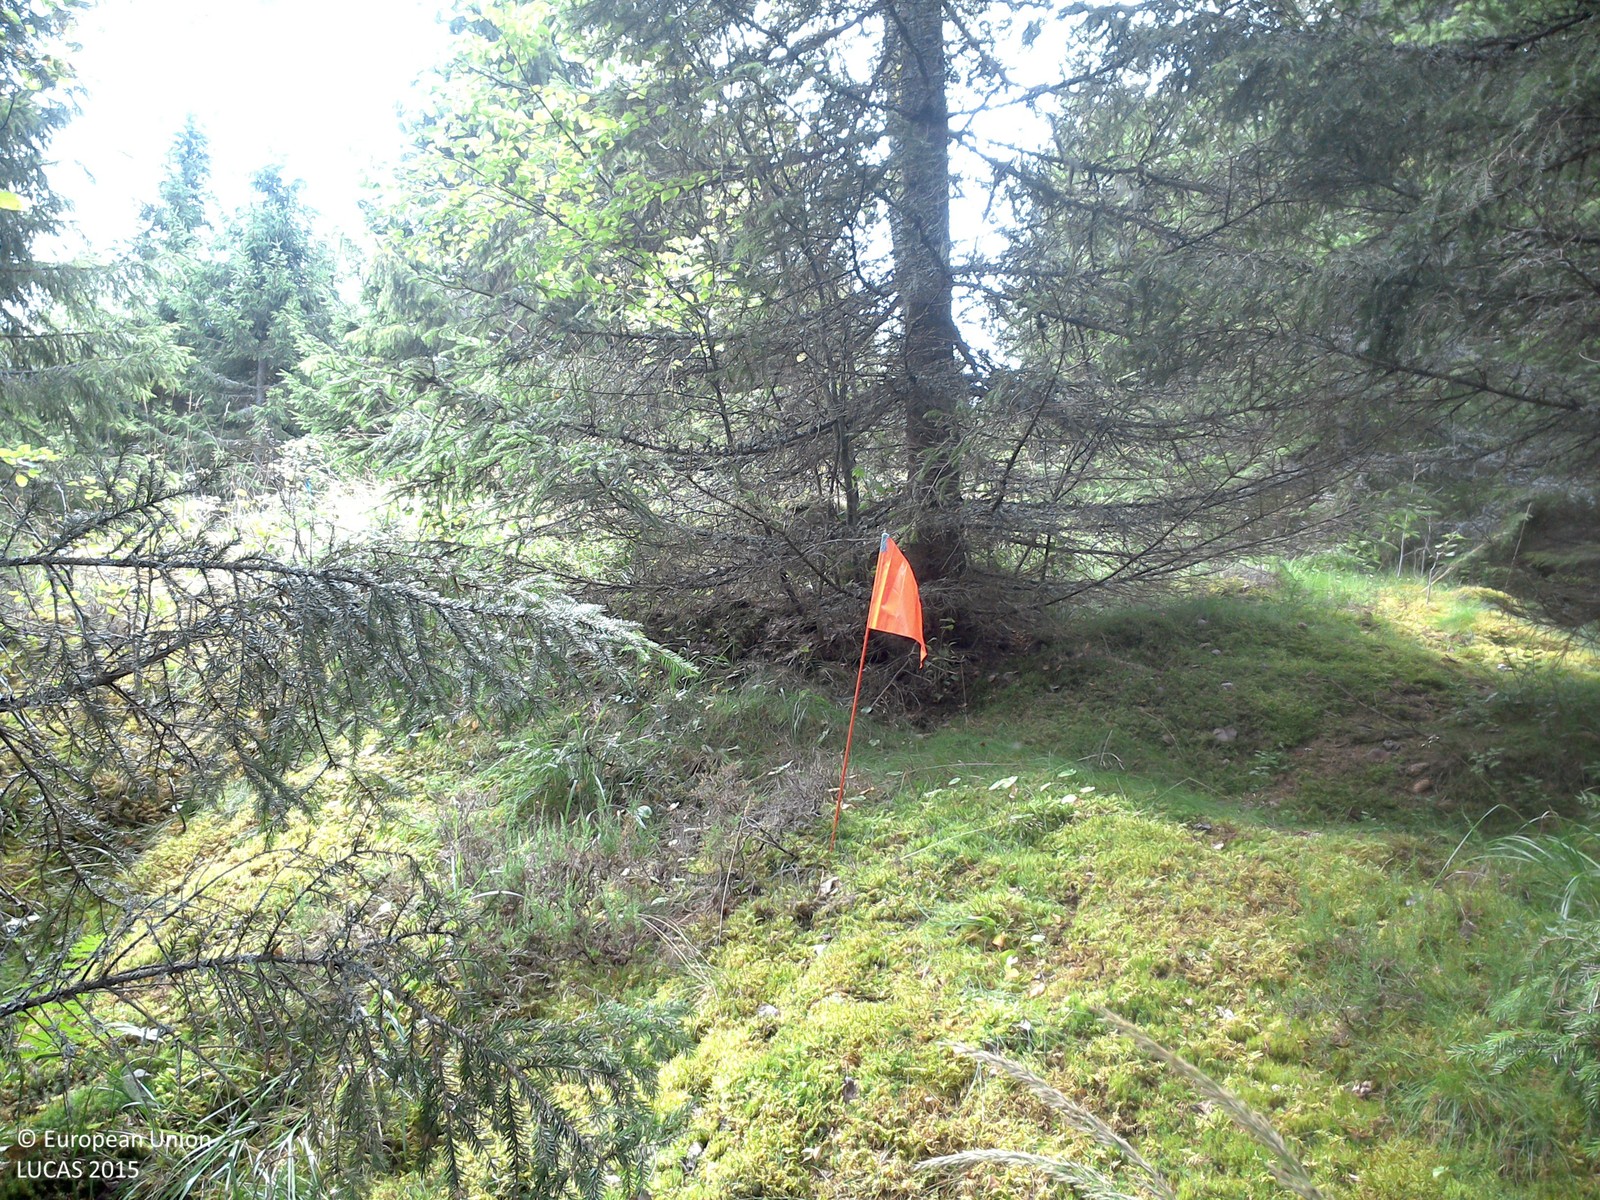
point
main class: Woodland
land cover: Spruce dominated coniferous woodland
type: boreal forest
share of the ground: 50 - 75 %
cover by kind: coniferous forest trees 55 %, lichens and mosses 30 %, herbaceous plants 15 %
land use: Forestry
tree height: > 5 m
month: August
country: SE
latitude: 57.8543
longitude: 15.5061
